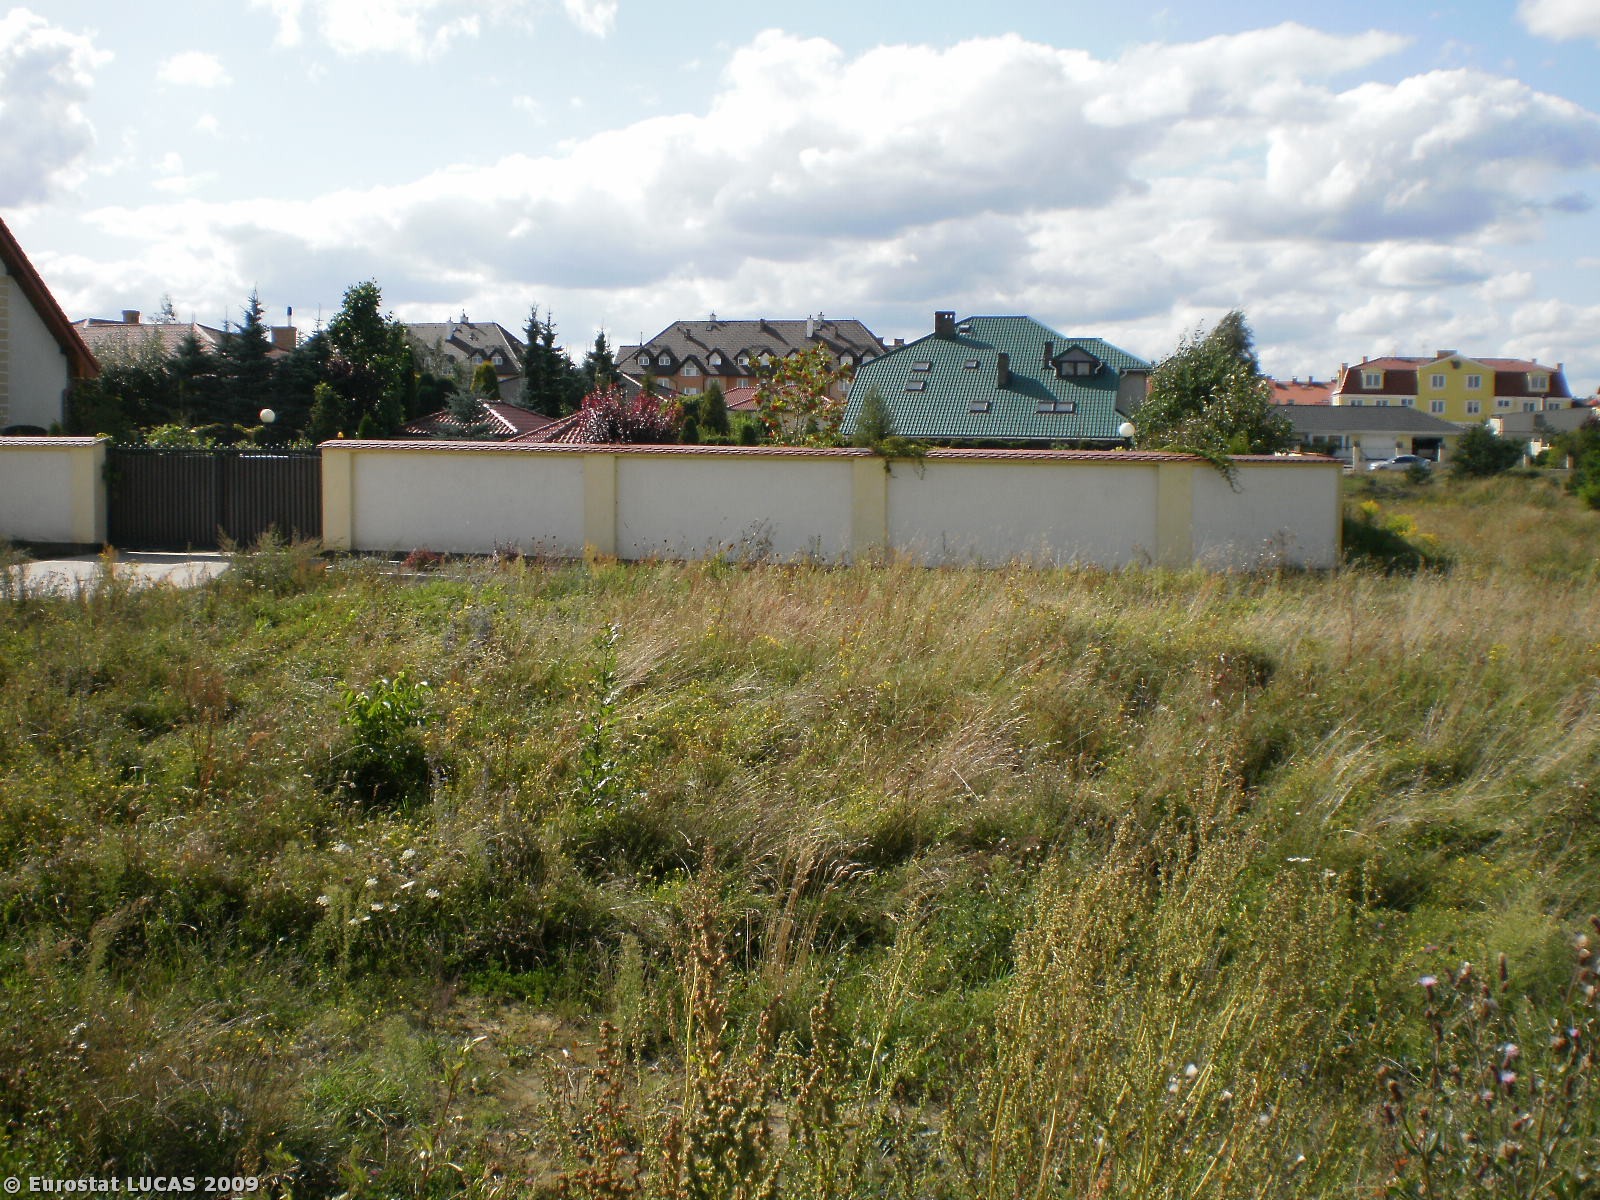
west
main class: Grassland
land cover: Spontaneously vegetated surfaces
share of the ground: > 75 %
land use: Unused
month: September
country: PL
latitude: 54.4241
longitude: 18.4785
